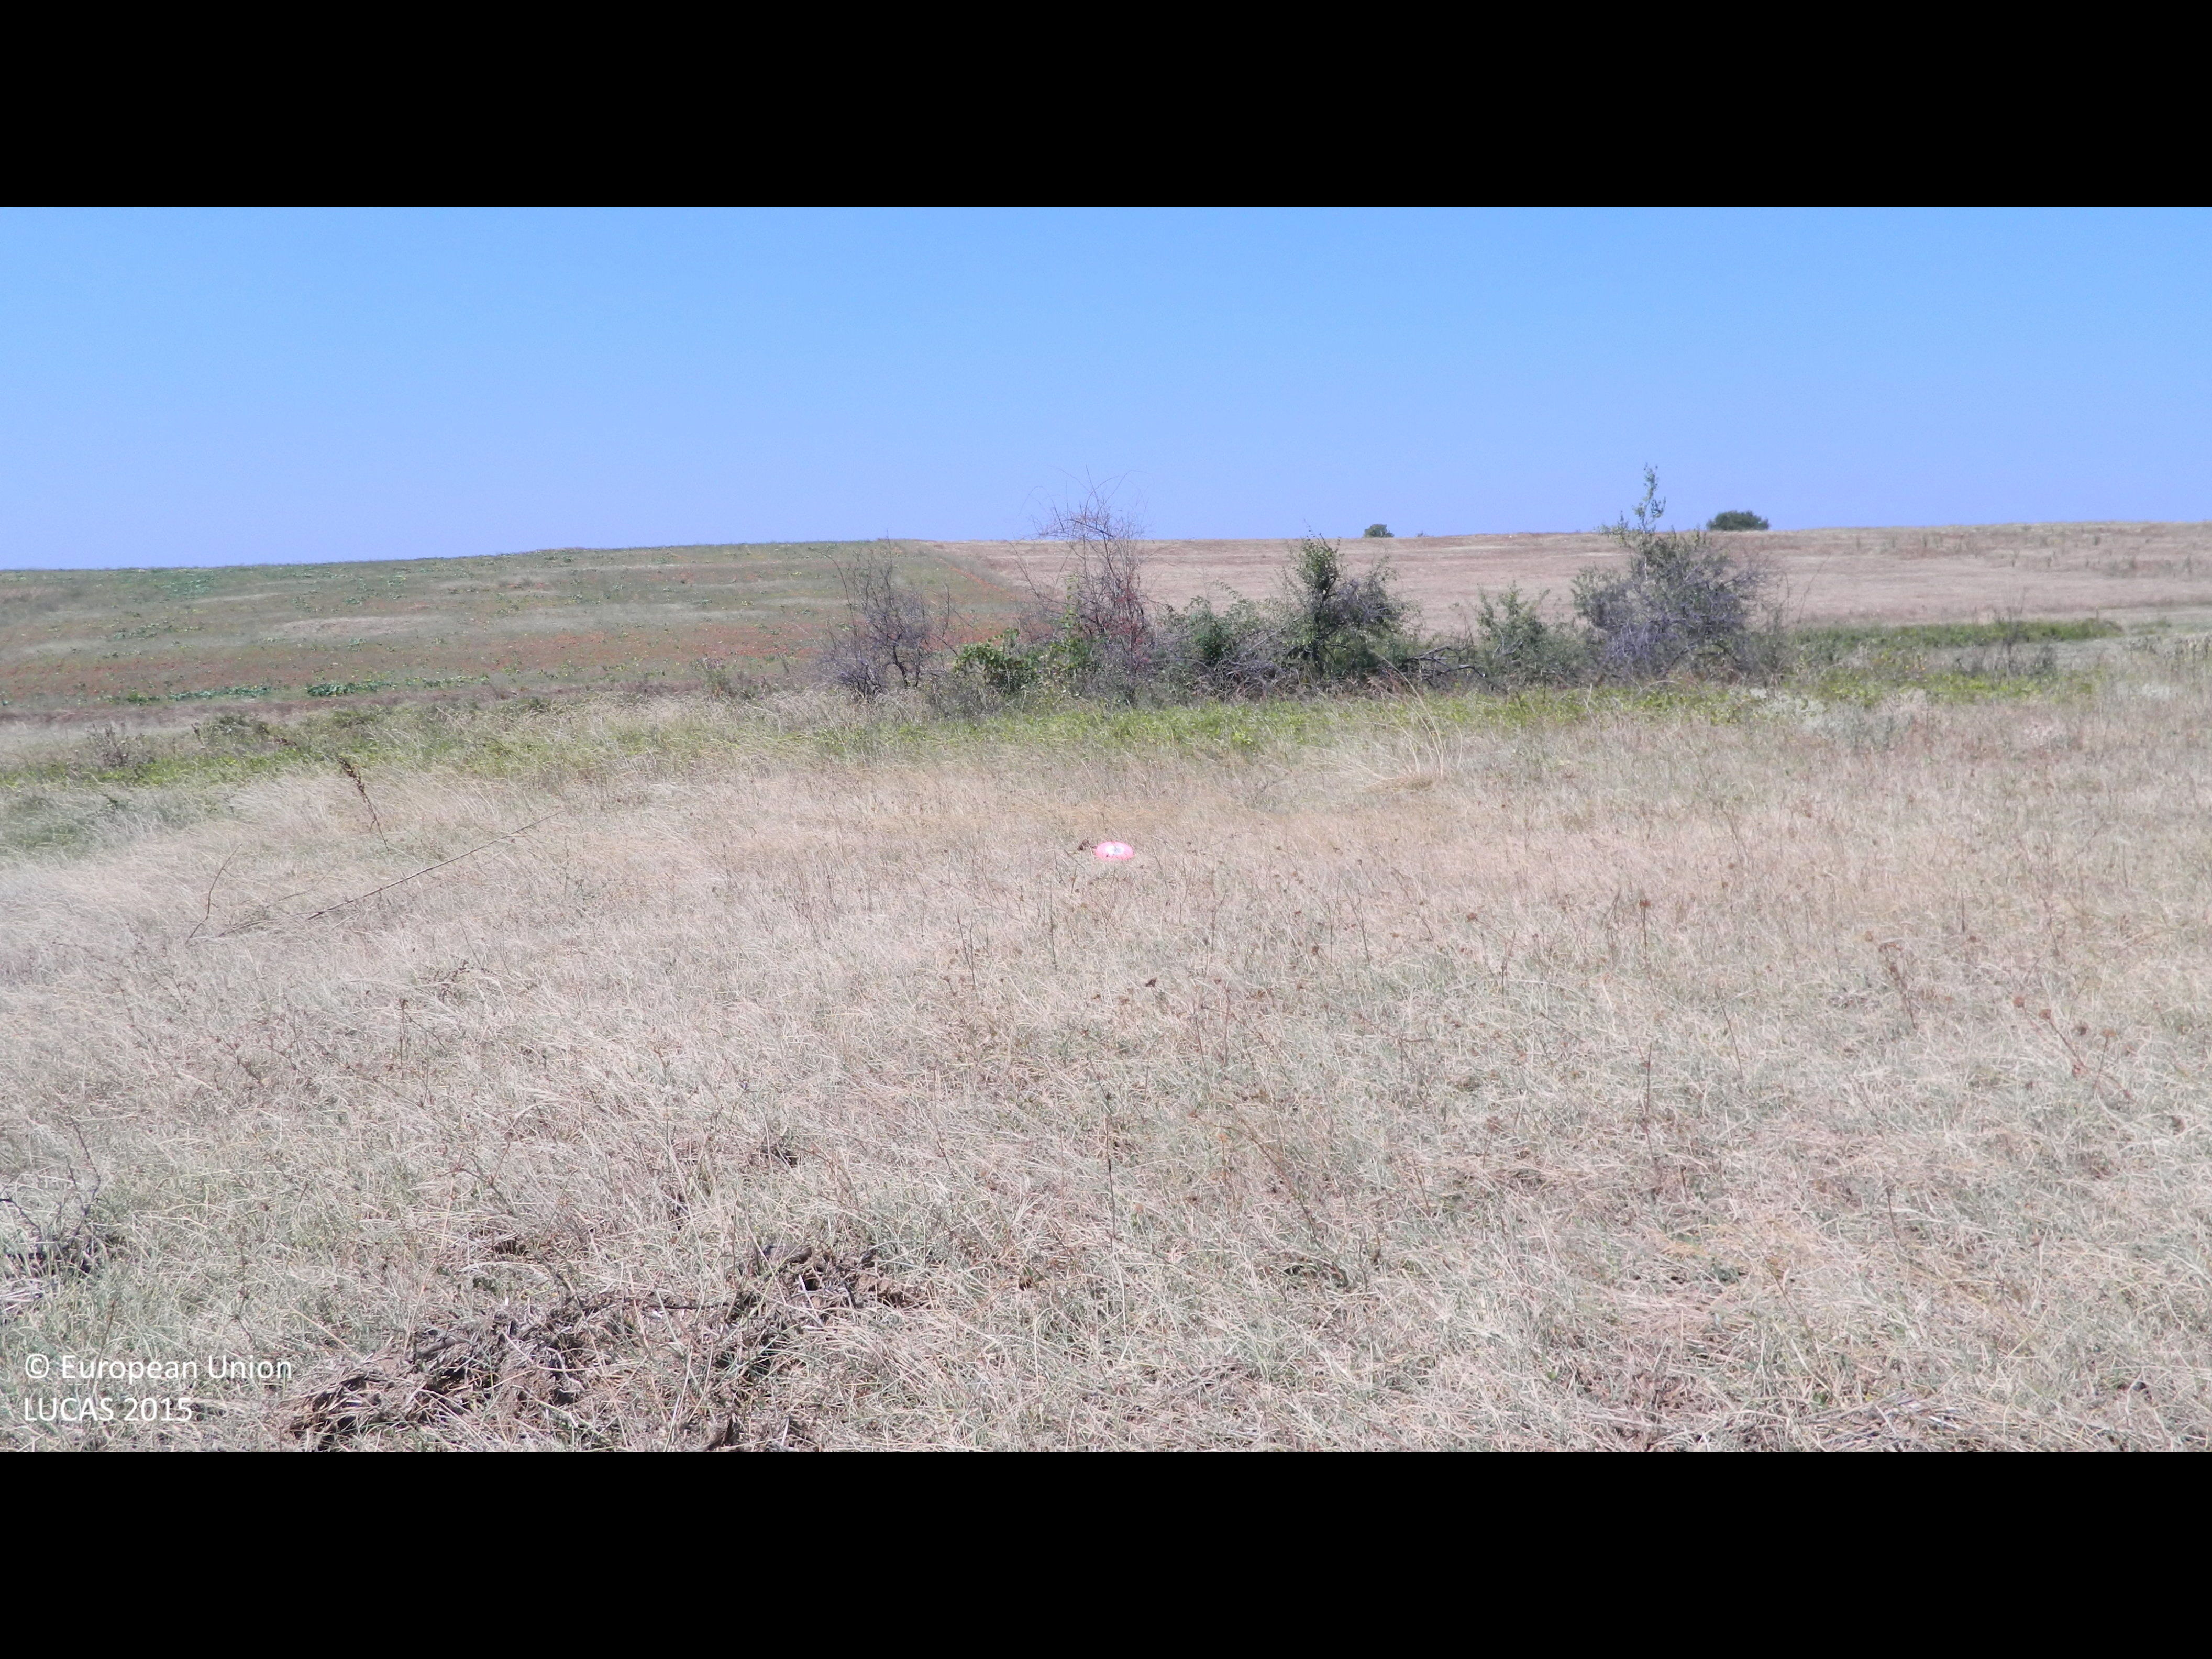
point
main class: Grassland
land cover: Grassland without tree/shrub cover
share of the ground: > 75 %
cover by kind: herbaceous plants 95 %, shrubs 5 %
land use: Agriculture (excluding fallow land and kitchen gardens)
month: August
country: BG
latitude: 41.4753
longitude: 25.9327
